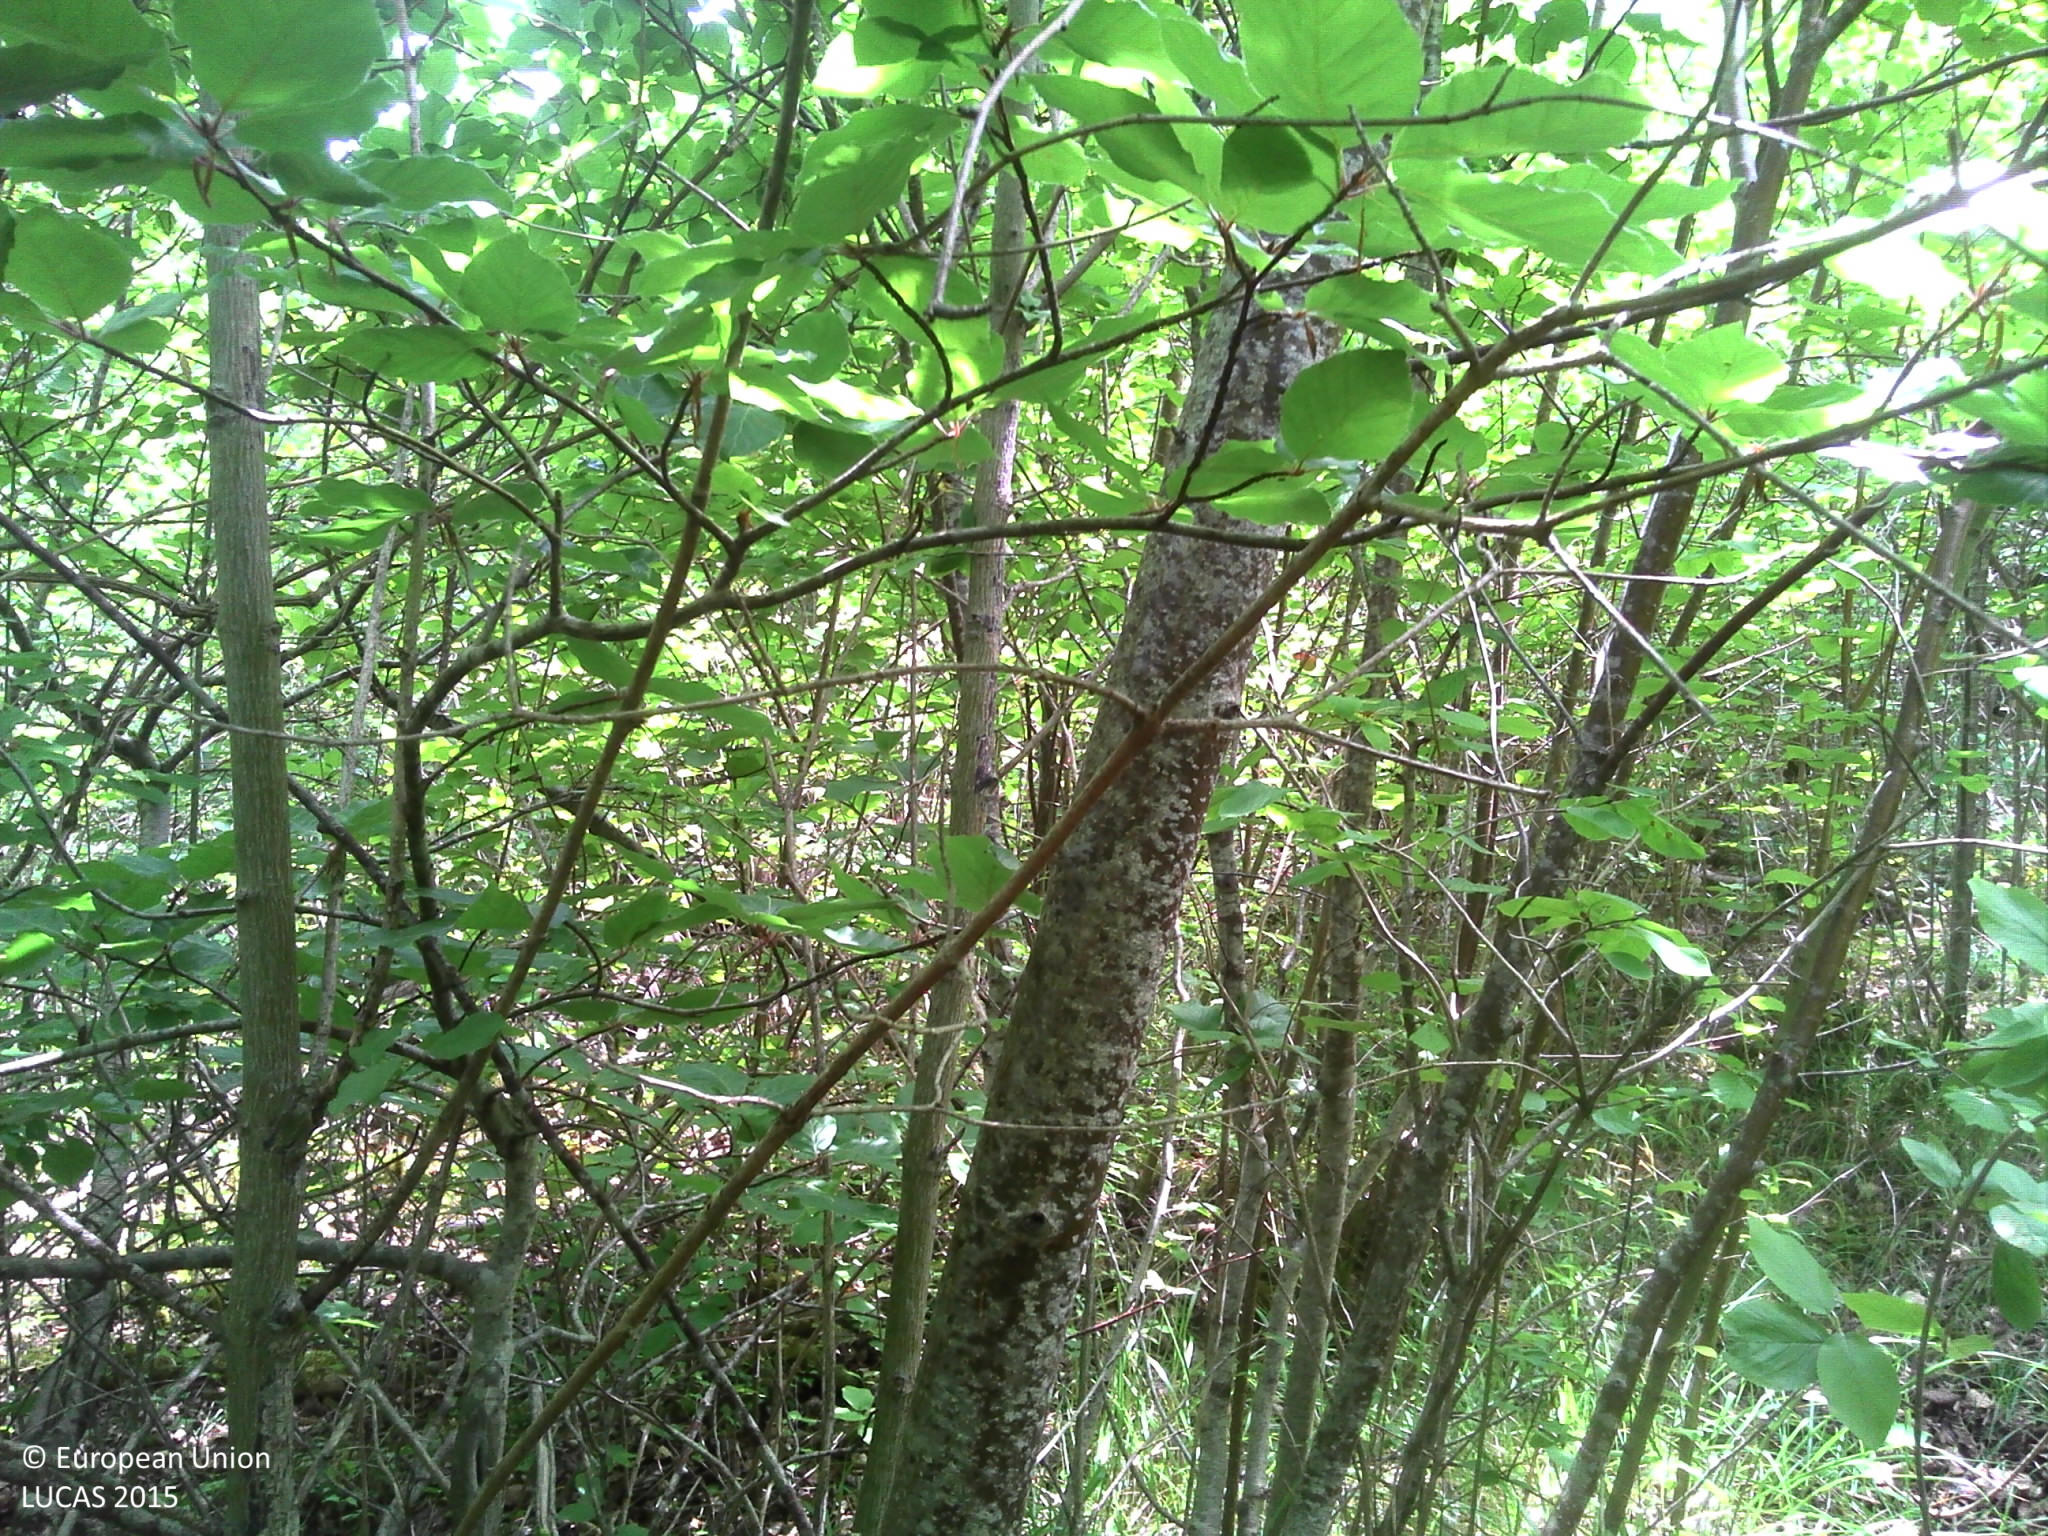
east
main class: Woodland
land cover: Broadleaved woodland
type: boreal forest
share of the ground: > 75 %
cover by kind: broadleaved forest trees 90 %, herbaceous plants 5 %, lichens and mosses 5 %
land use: Forestry
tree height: > 5 m
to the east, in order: Broadleaved woodland; Grass margins; Barley
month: July
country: FR
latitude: 47.5963
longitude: 3.4658
